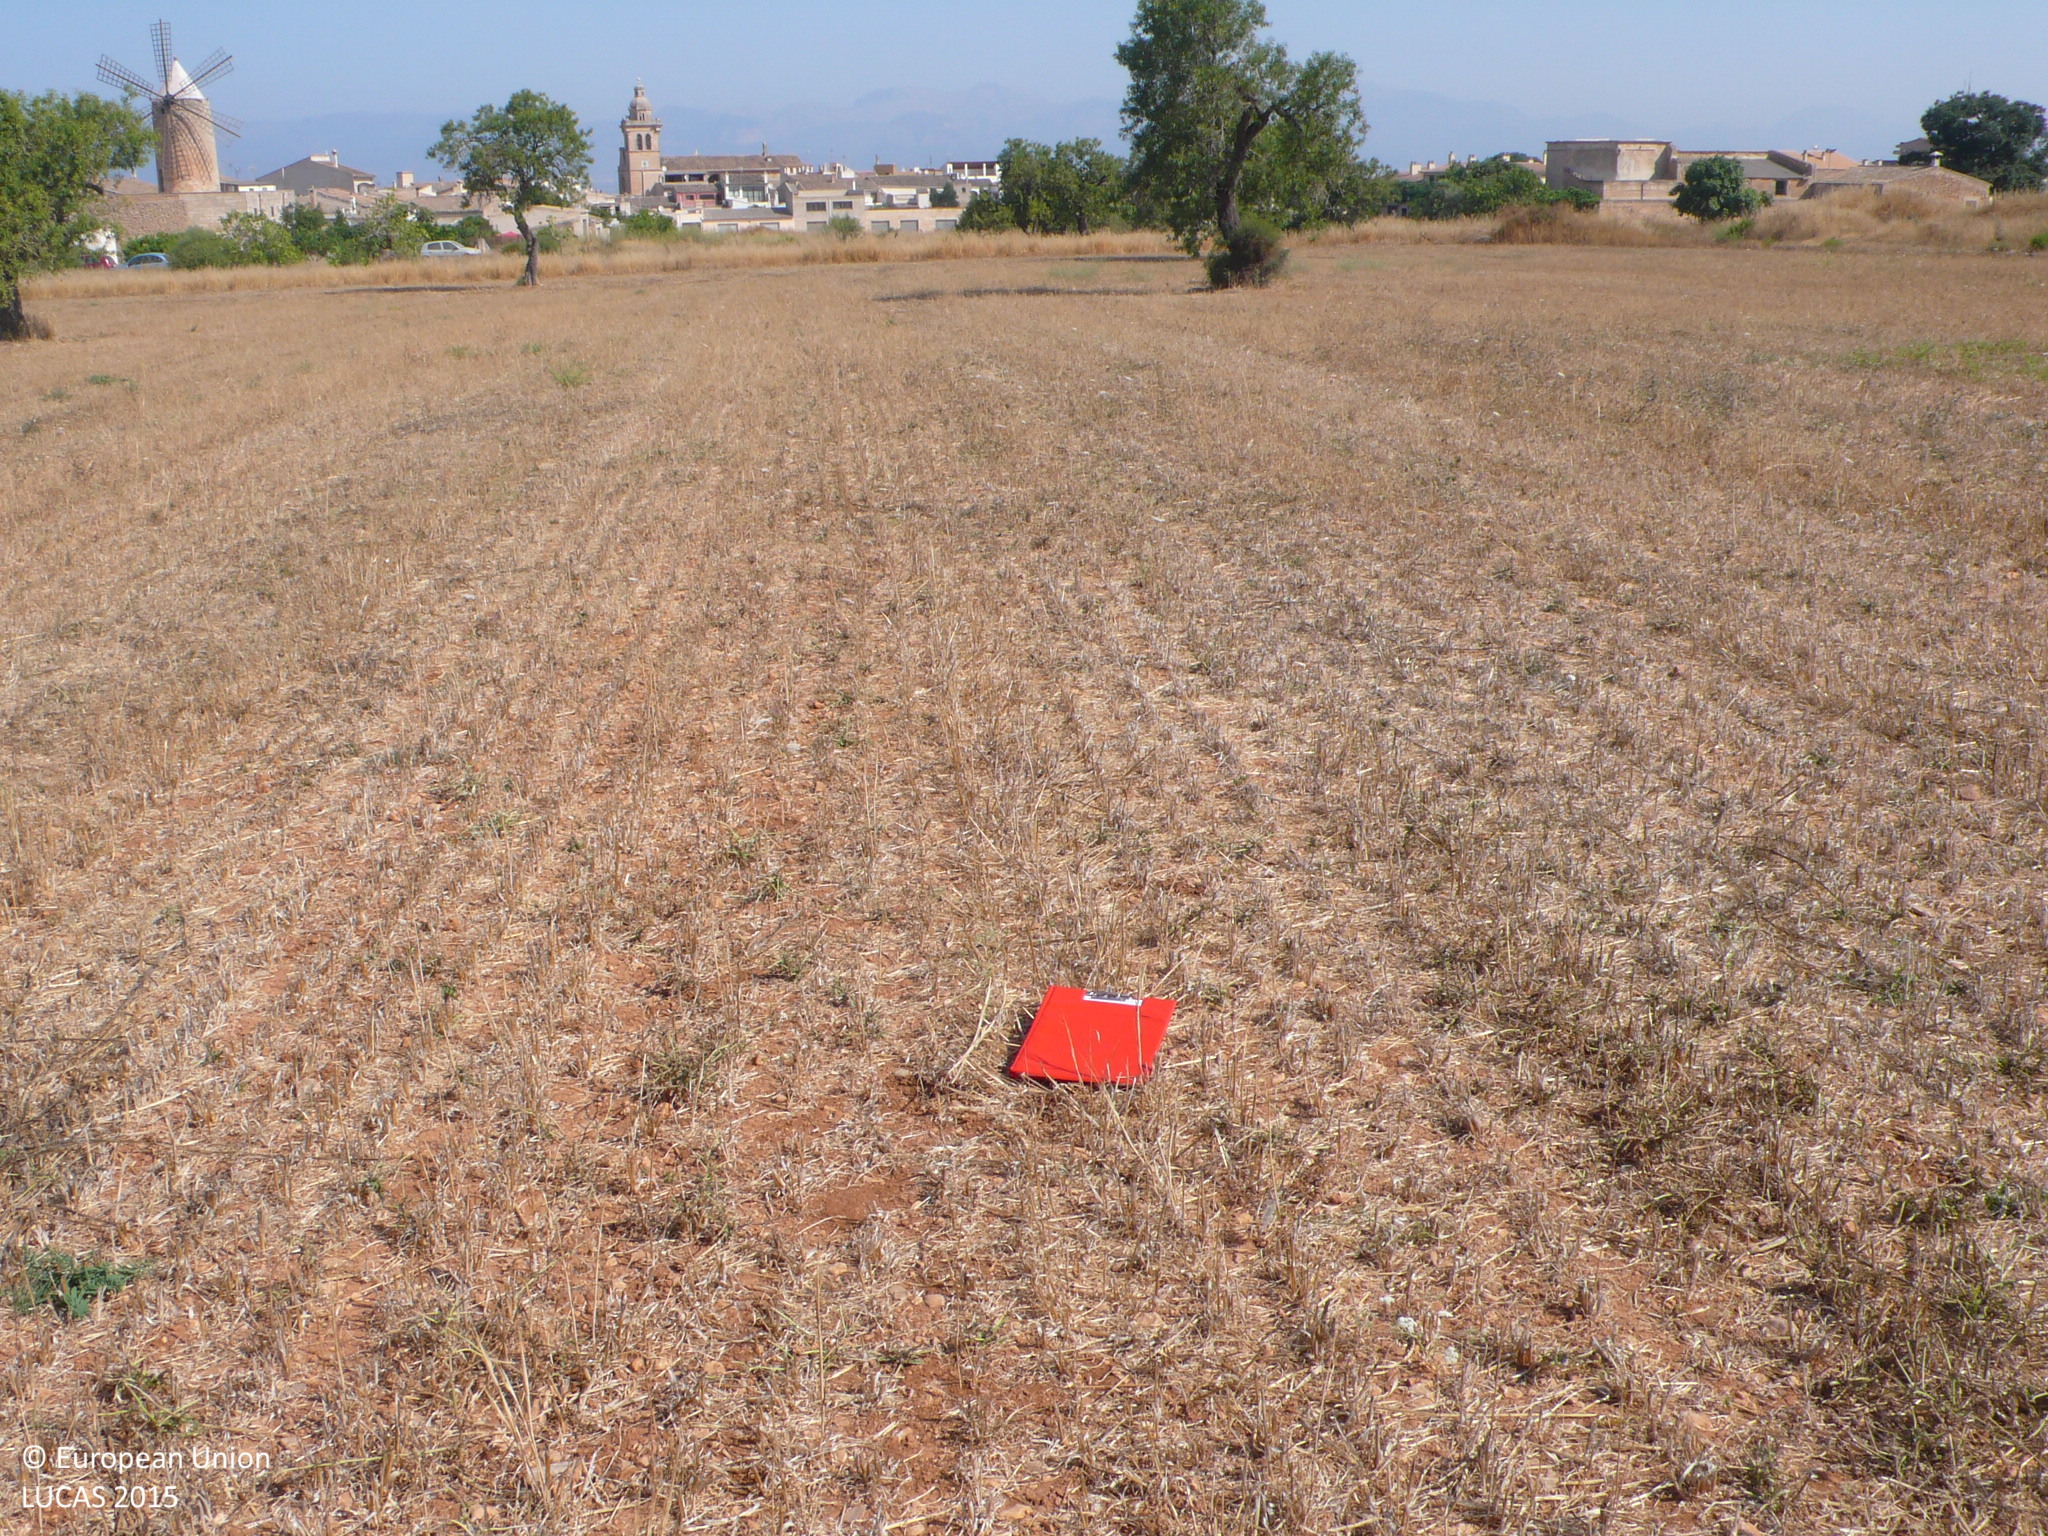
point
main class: Cropland
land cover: Barley
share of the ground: < 10 %
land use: Agriculture (excluding fallow land and kitchen gardens)
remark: Harvested field
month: July
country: ES
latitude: 39.5554
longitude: 2.8962
